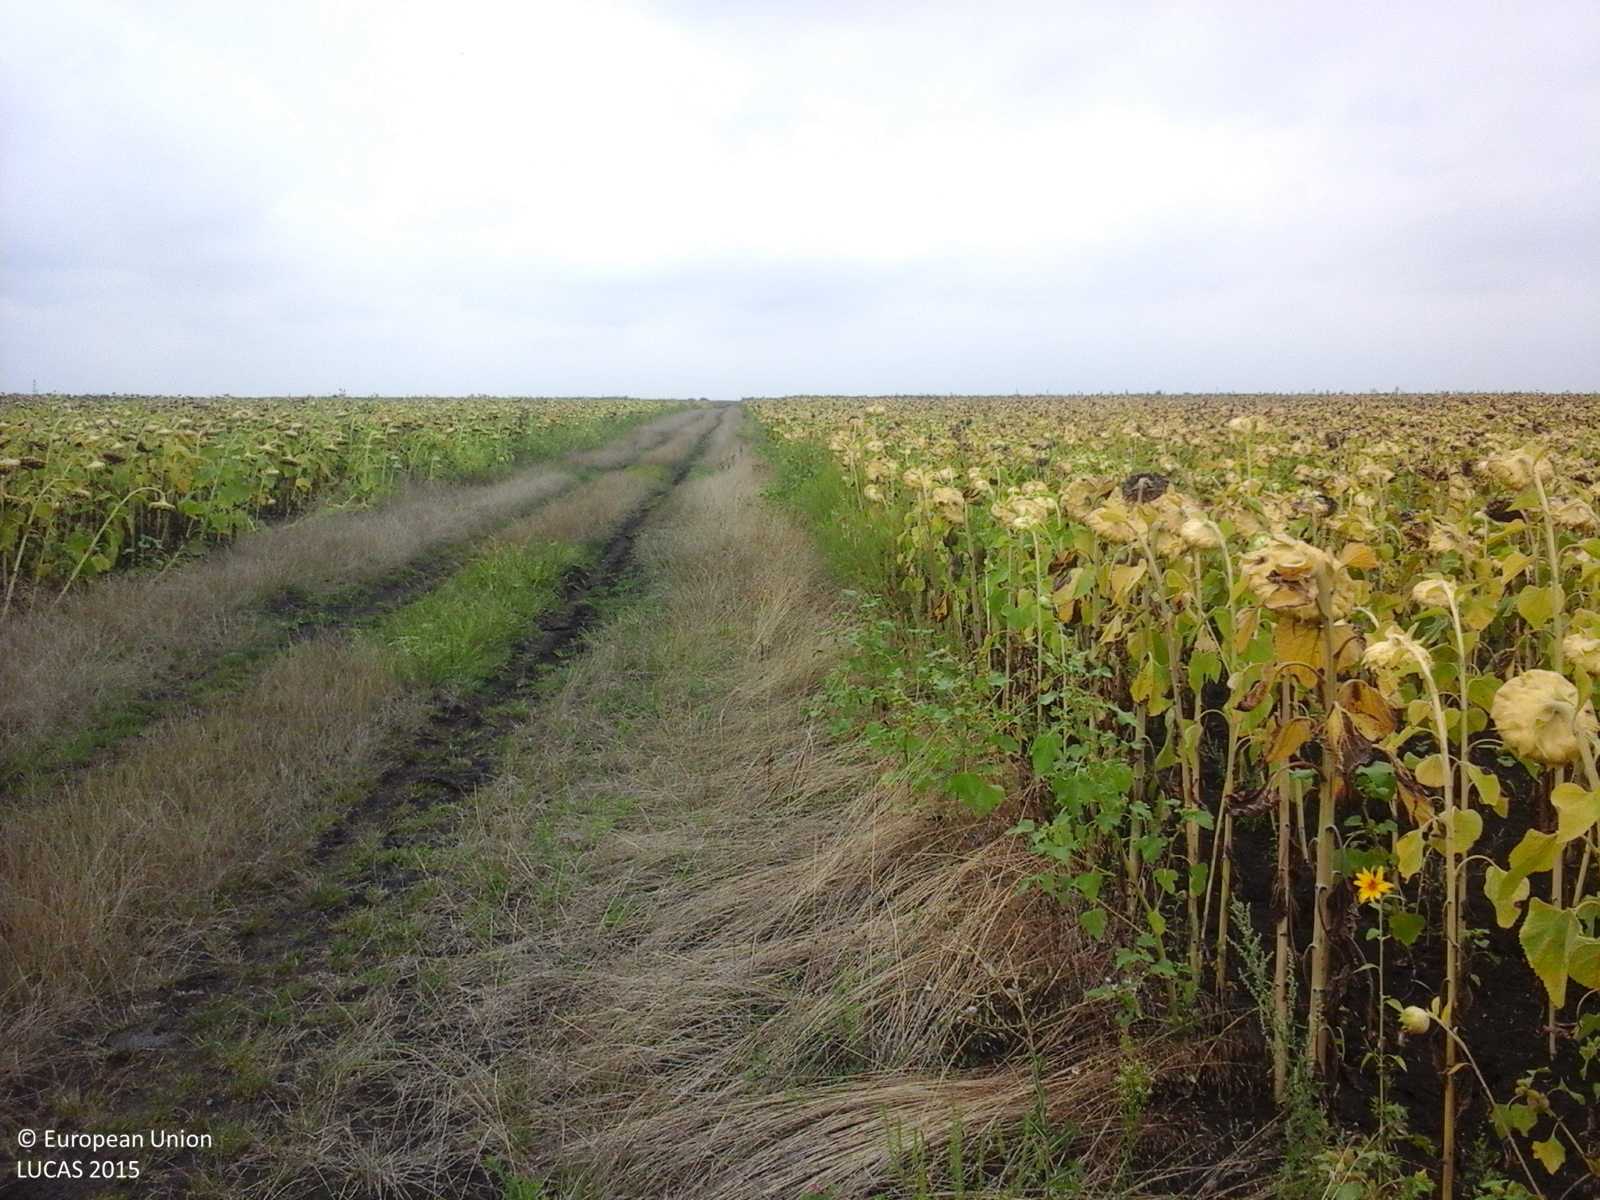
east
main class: Cropland
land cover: Sunflower
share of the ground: > 75 %
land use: Agriculture (excluding fallow land and kitchen gardens)
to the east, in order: Sunflower
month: August
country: RO
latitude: 46.1163
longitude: 20.3882
